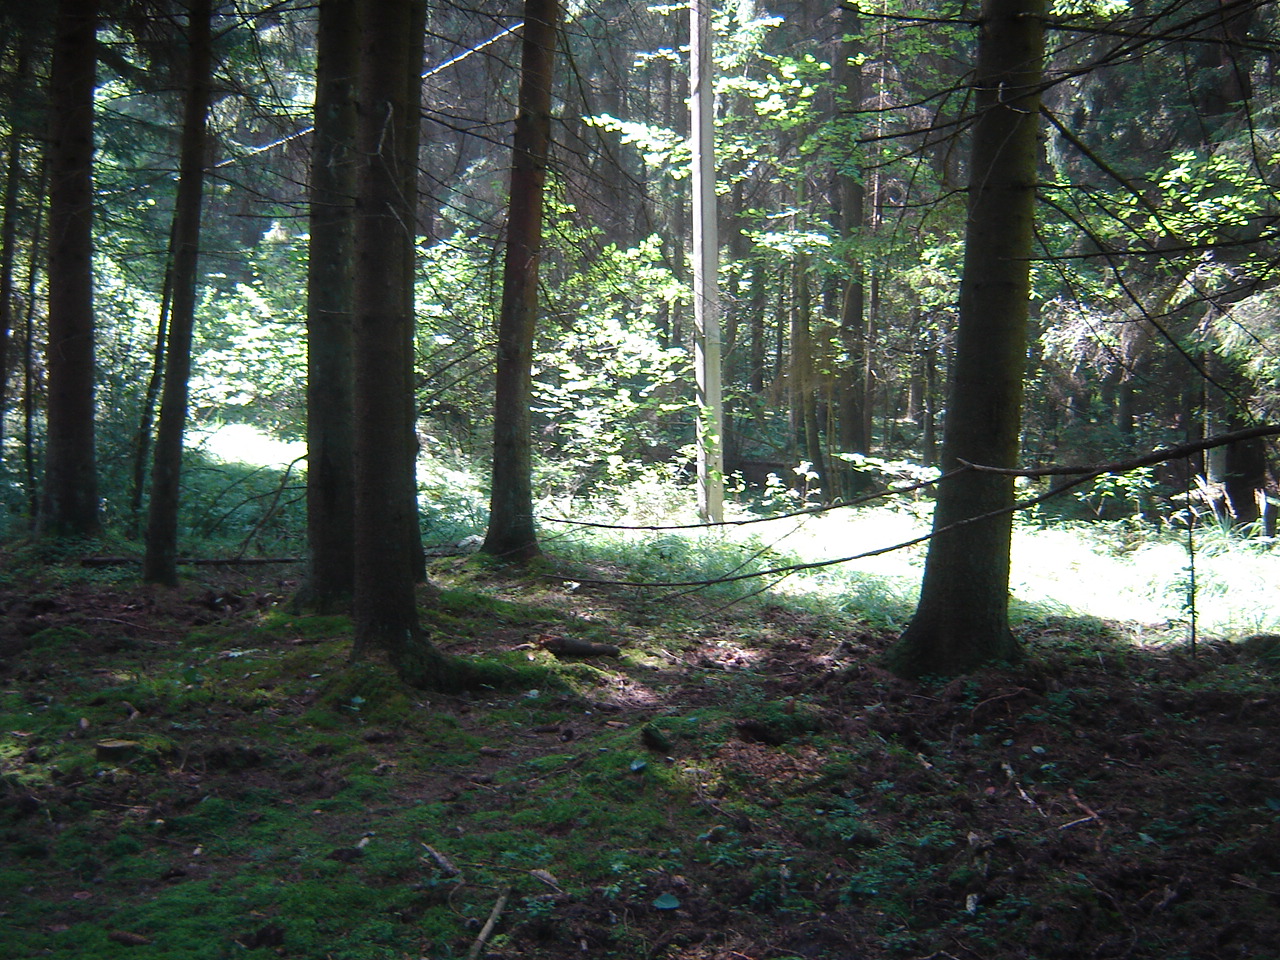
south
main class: Woodland
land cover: Spruce dominated coniferous woodland
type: hemiboreal forest and nemoral coniferous forest and mixed broadleaved-coniferous forest
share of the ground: > 75 %
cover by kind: coniferous forest trees 85 %, broadleaved forest trees 10 %, lichens and mosses 5 %
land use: Forestry
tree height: > 5 m
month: August
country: LT
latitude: 54.9514
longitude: 24.9937
